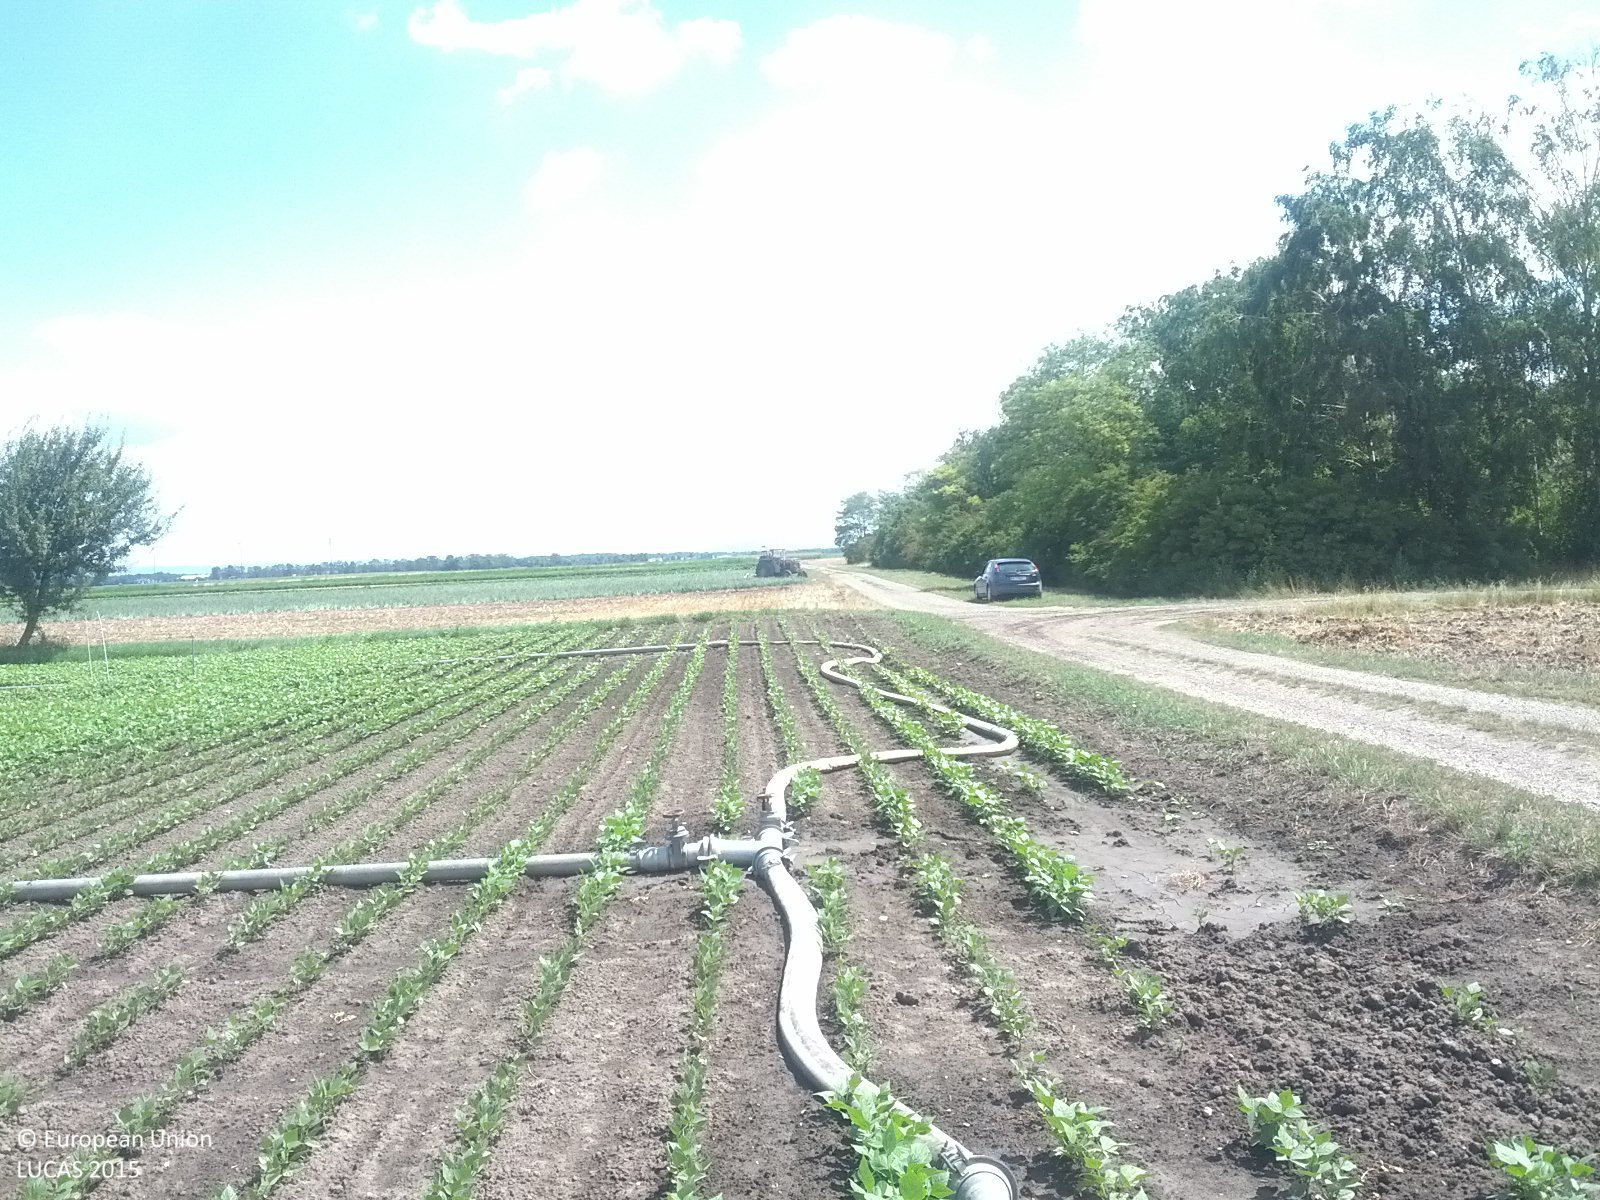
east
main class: Cropland
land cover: Other fresh vegetables
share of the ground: 10 - 25 %
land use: Agriculture (excluding fallow land and kitchen gardens)
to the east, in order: Other fresh vegetables; Grass margins; Tracks; Grass margins; Common wheat; Other fresh vegetables; Sugar beet; Common wheat; Potatoes
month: July
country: AT
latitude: 48.2218
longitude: 16.6420
